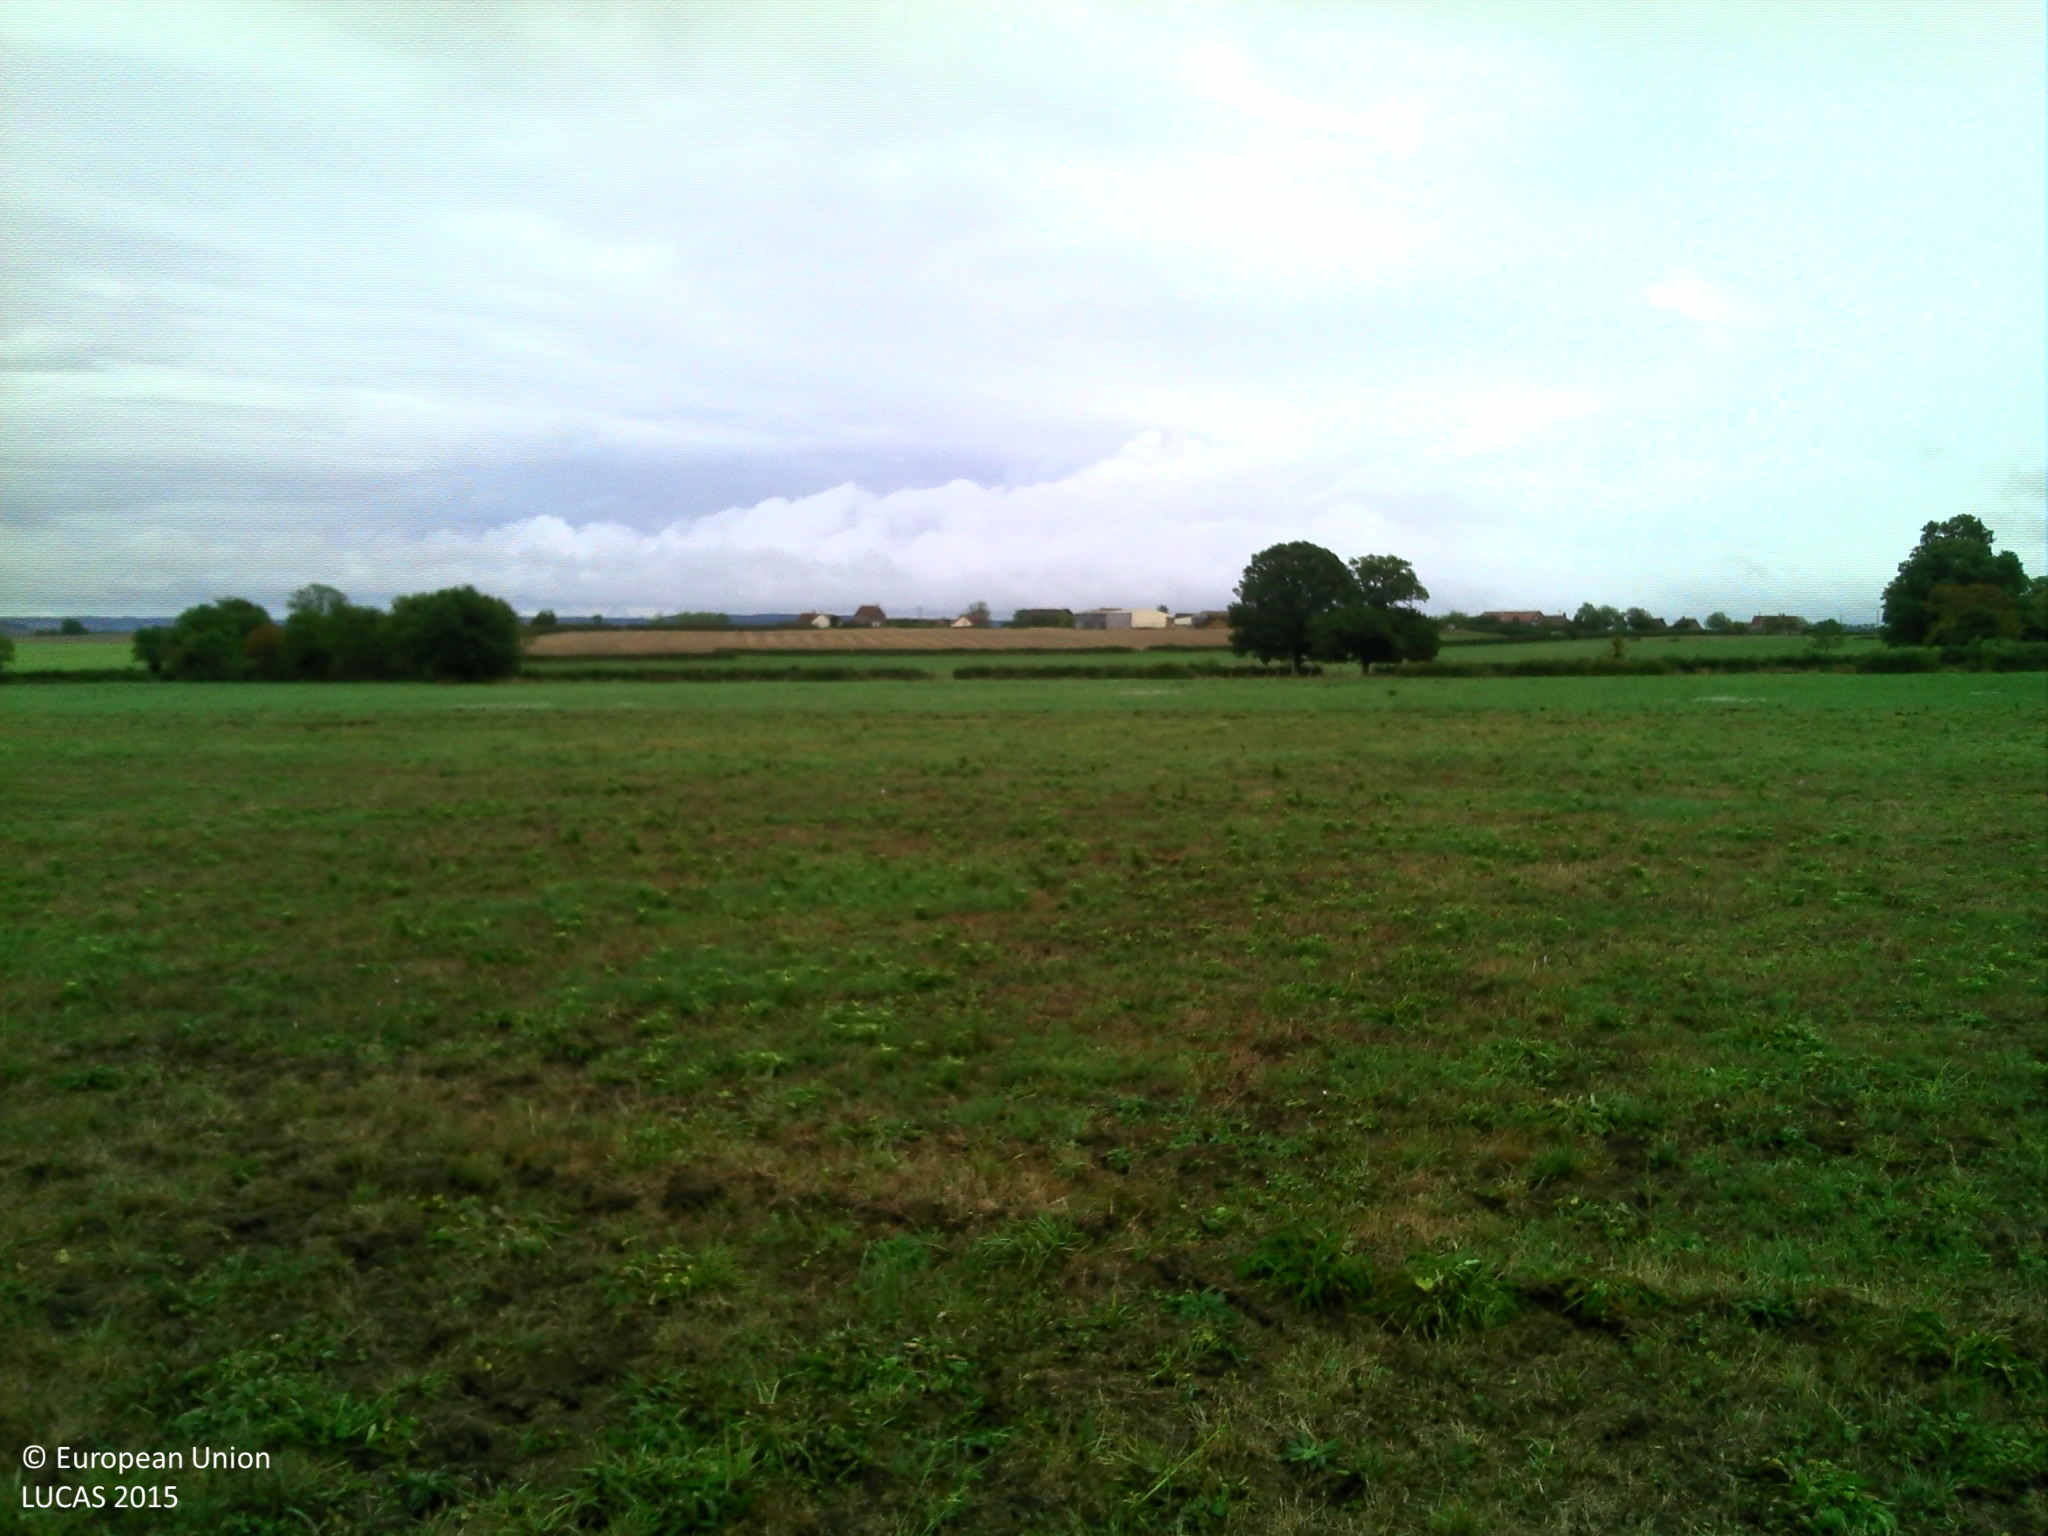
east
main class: Grassland
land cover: Grassland without tree/shrub cover
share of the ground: > 75 %
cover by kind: herbaceous plants 100 %
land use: Agriculture (excluding fallow land and kitchen gardens)
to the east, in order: Grassland without tree/shrub cover; Fences; Ditches and canals; Grassland without tree/shrub cover
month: September
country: FR
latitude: 47.3582
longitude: 4.3722
